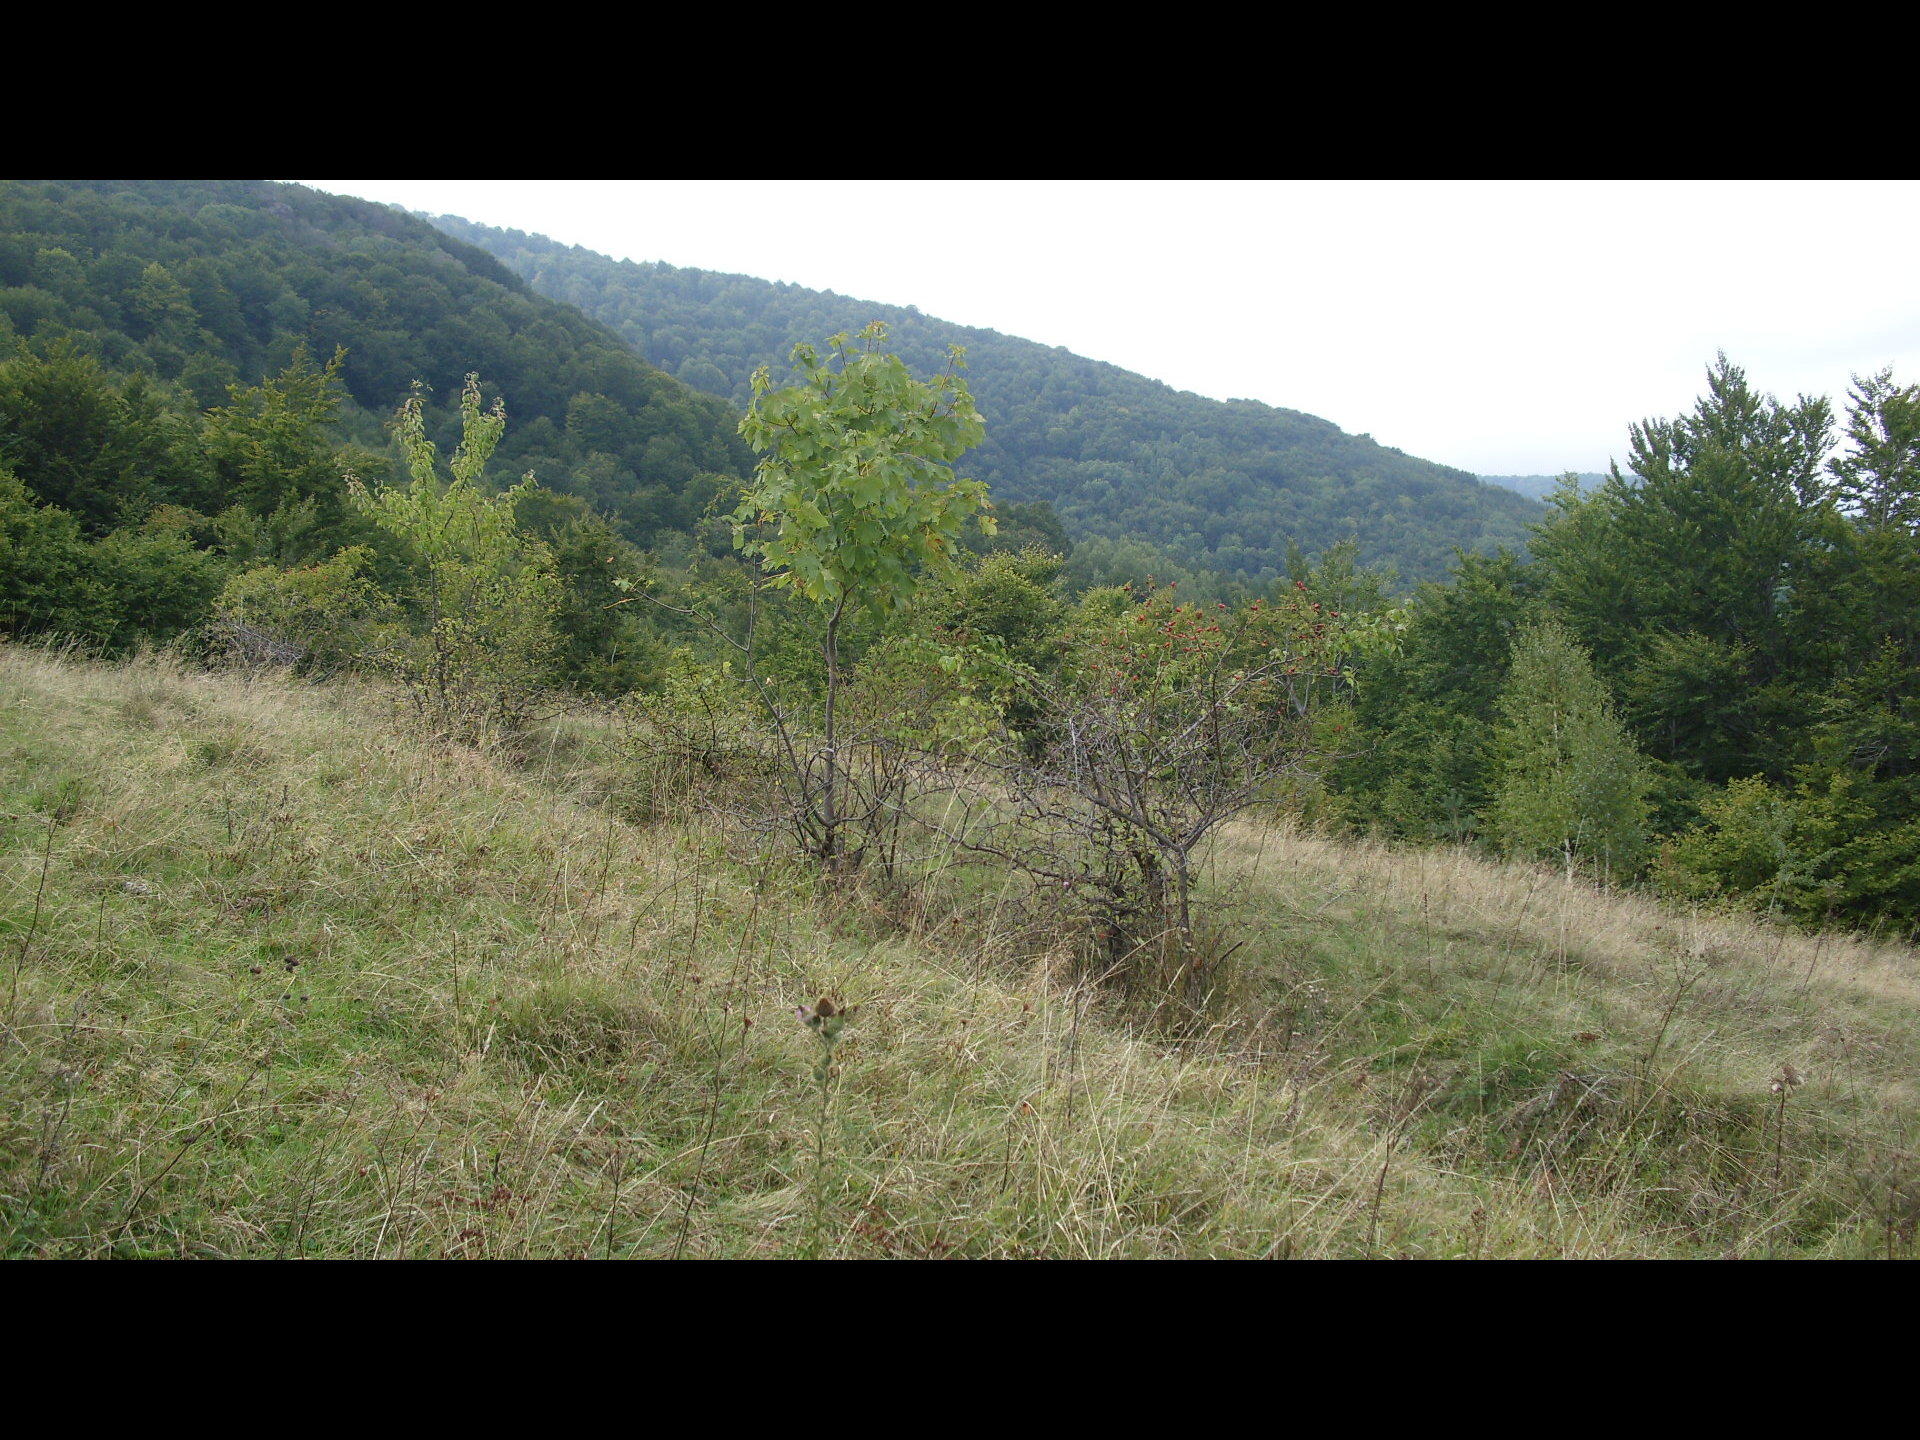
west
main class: Grassland
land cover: Grassland with sparse tree/shrub cover
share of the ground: > 75 %
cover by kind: herbaceous plants 90 %, broadleaved forest trees 5 %, shrubs 5 %
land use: Agriculture (excluding fallow land and kitchen gardens)
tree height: < 5 m
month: October
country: BG
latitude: 43.3470
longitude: 22.8512
